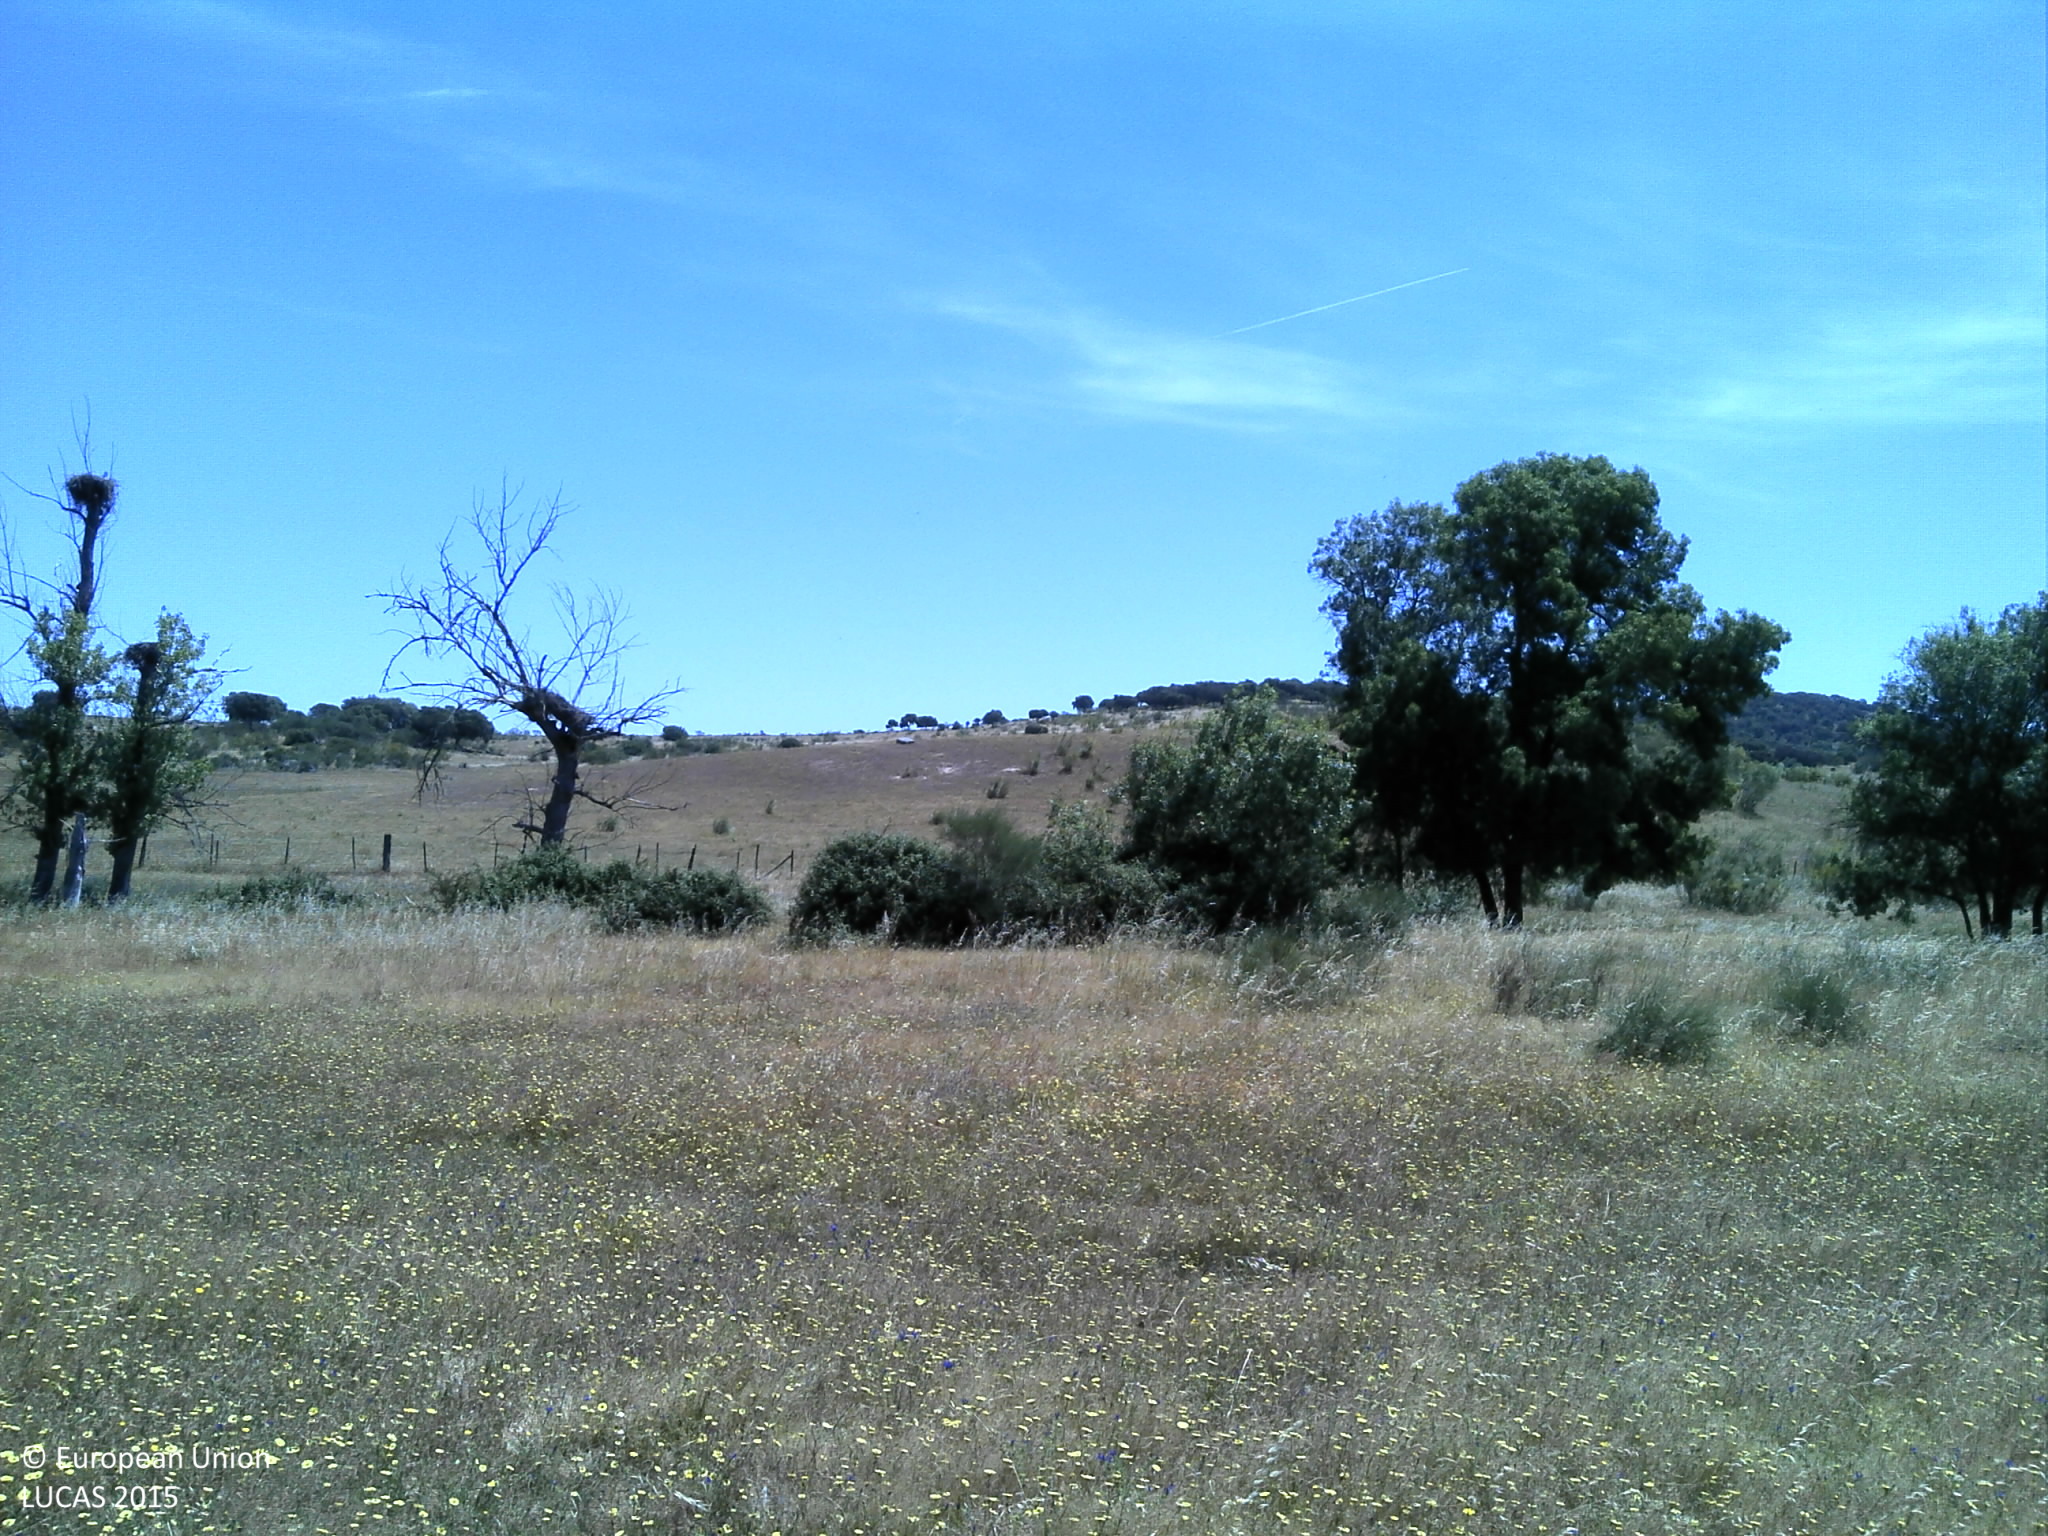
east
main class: Grassland
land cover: Grassland without tree/shrub cover
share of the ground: 50 - 75 %
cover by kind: herbaceous plants 60 %, unconsolidated bare surface 40 %
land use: Agriculture (excluding fallow land and kitchen gardens)
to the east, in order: Grassland without tree/shrub cover; Shrubland with sparse tree cover; Broadleaved woodland; Rivers and streams; Grassland with sparse tree/shrub cover; Fences; Grassland with sparse tree/shrub cover
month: May
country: PT
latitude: 39.2404
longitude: -7.6685
